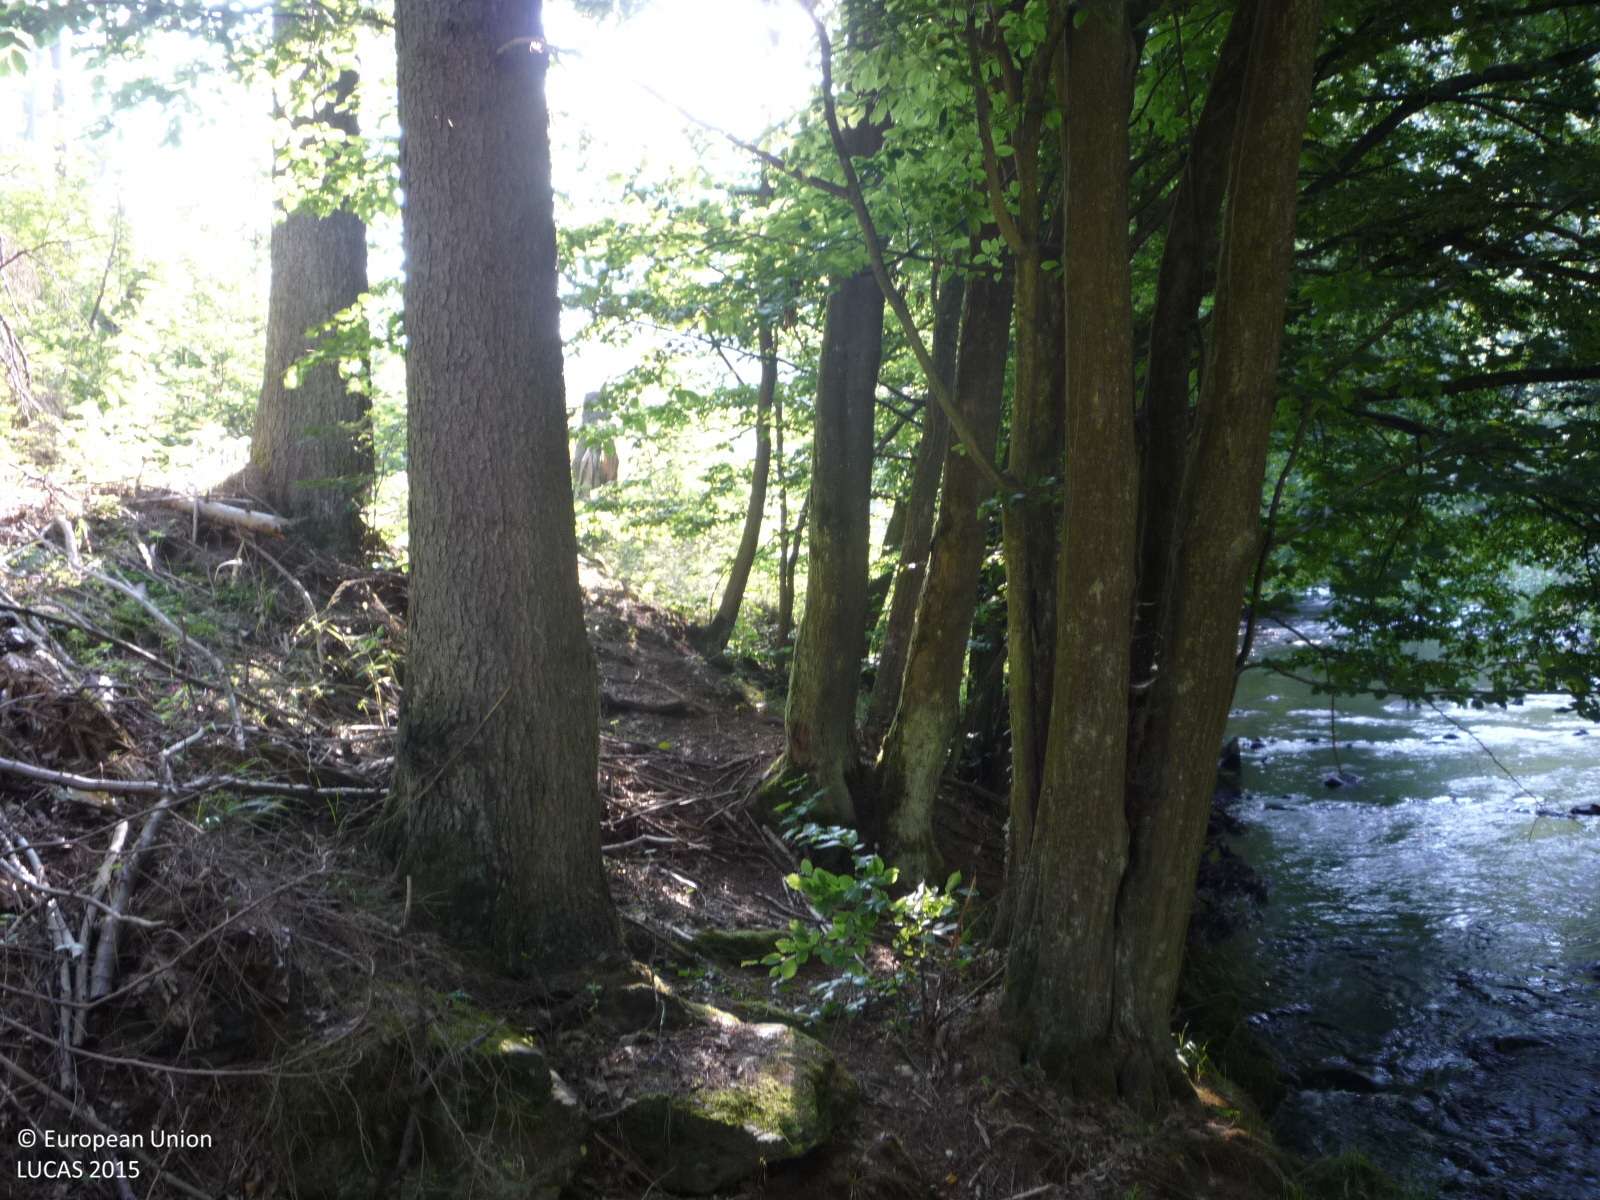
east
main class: Woodland
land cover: Spruce dominated coniferous woodland
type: hemiboreal forest and nemoral coniferous forest and mixed broadleaved-coniferous forest
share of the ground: > 75 %
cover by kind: coniferous forest trees 85 %, broadleaved forest trees 5 %, herbaceous plants 5 %, unconsolidated bare surface 5 %
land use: Forestry
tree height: > 5 m
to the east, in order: Spruce dominated coniferous woodland; Fences; Other mixed woodland; Fences; Other bare soil; Inland fresh running water; Broadleaved woodland; Railways; Broadleaved woodland
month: August
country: CZ
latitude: 50.6374
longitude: 15.3060
